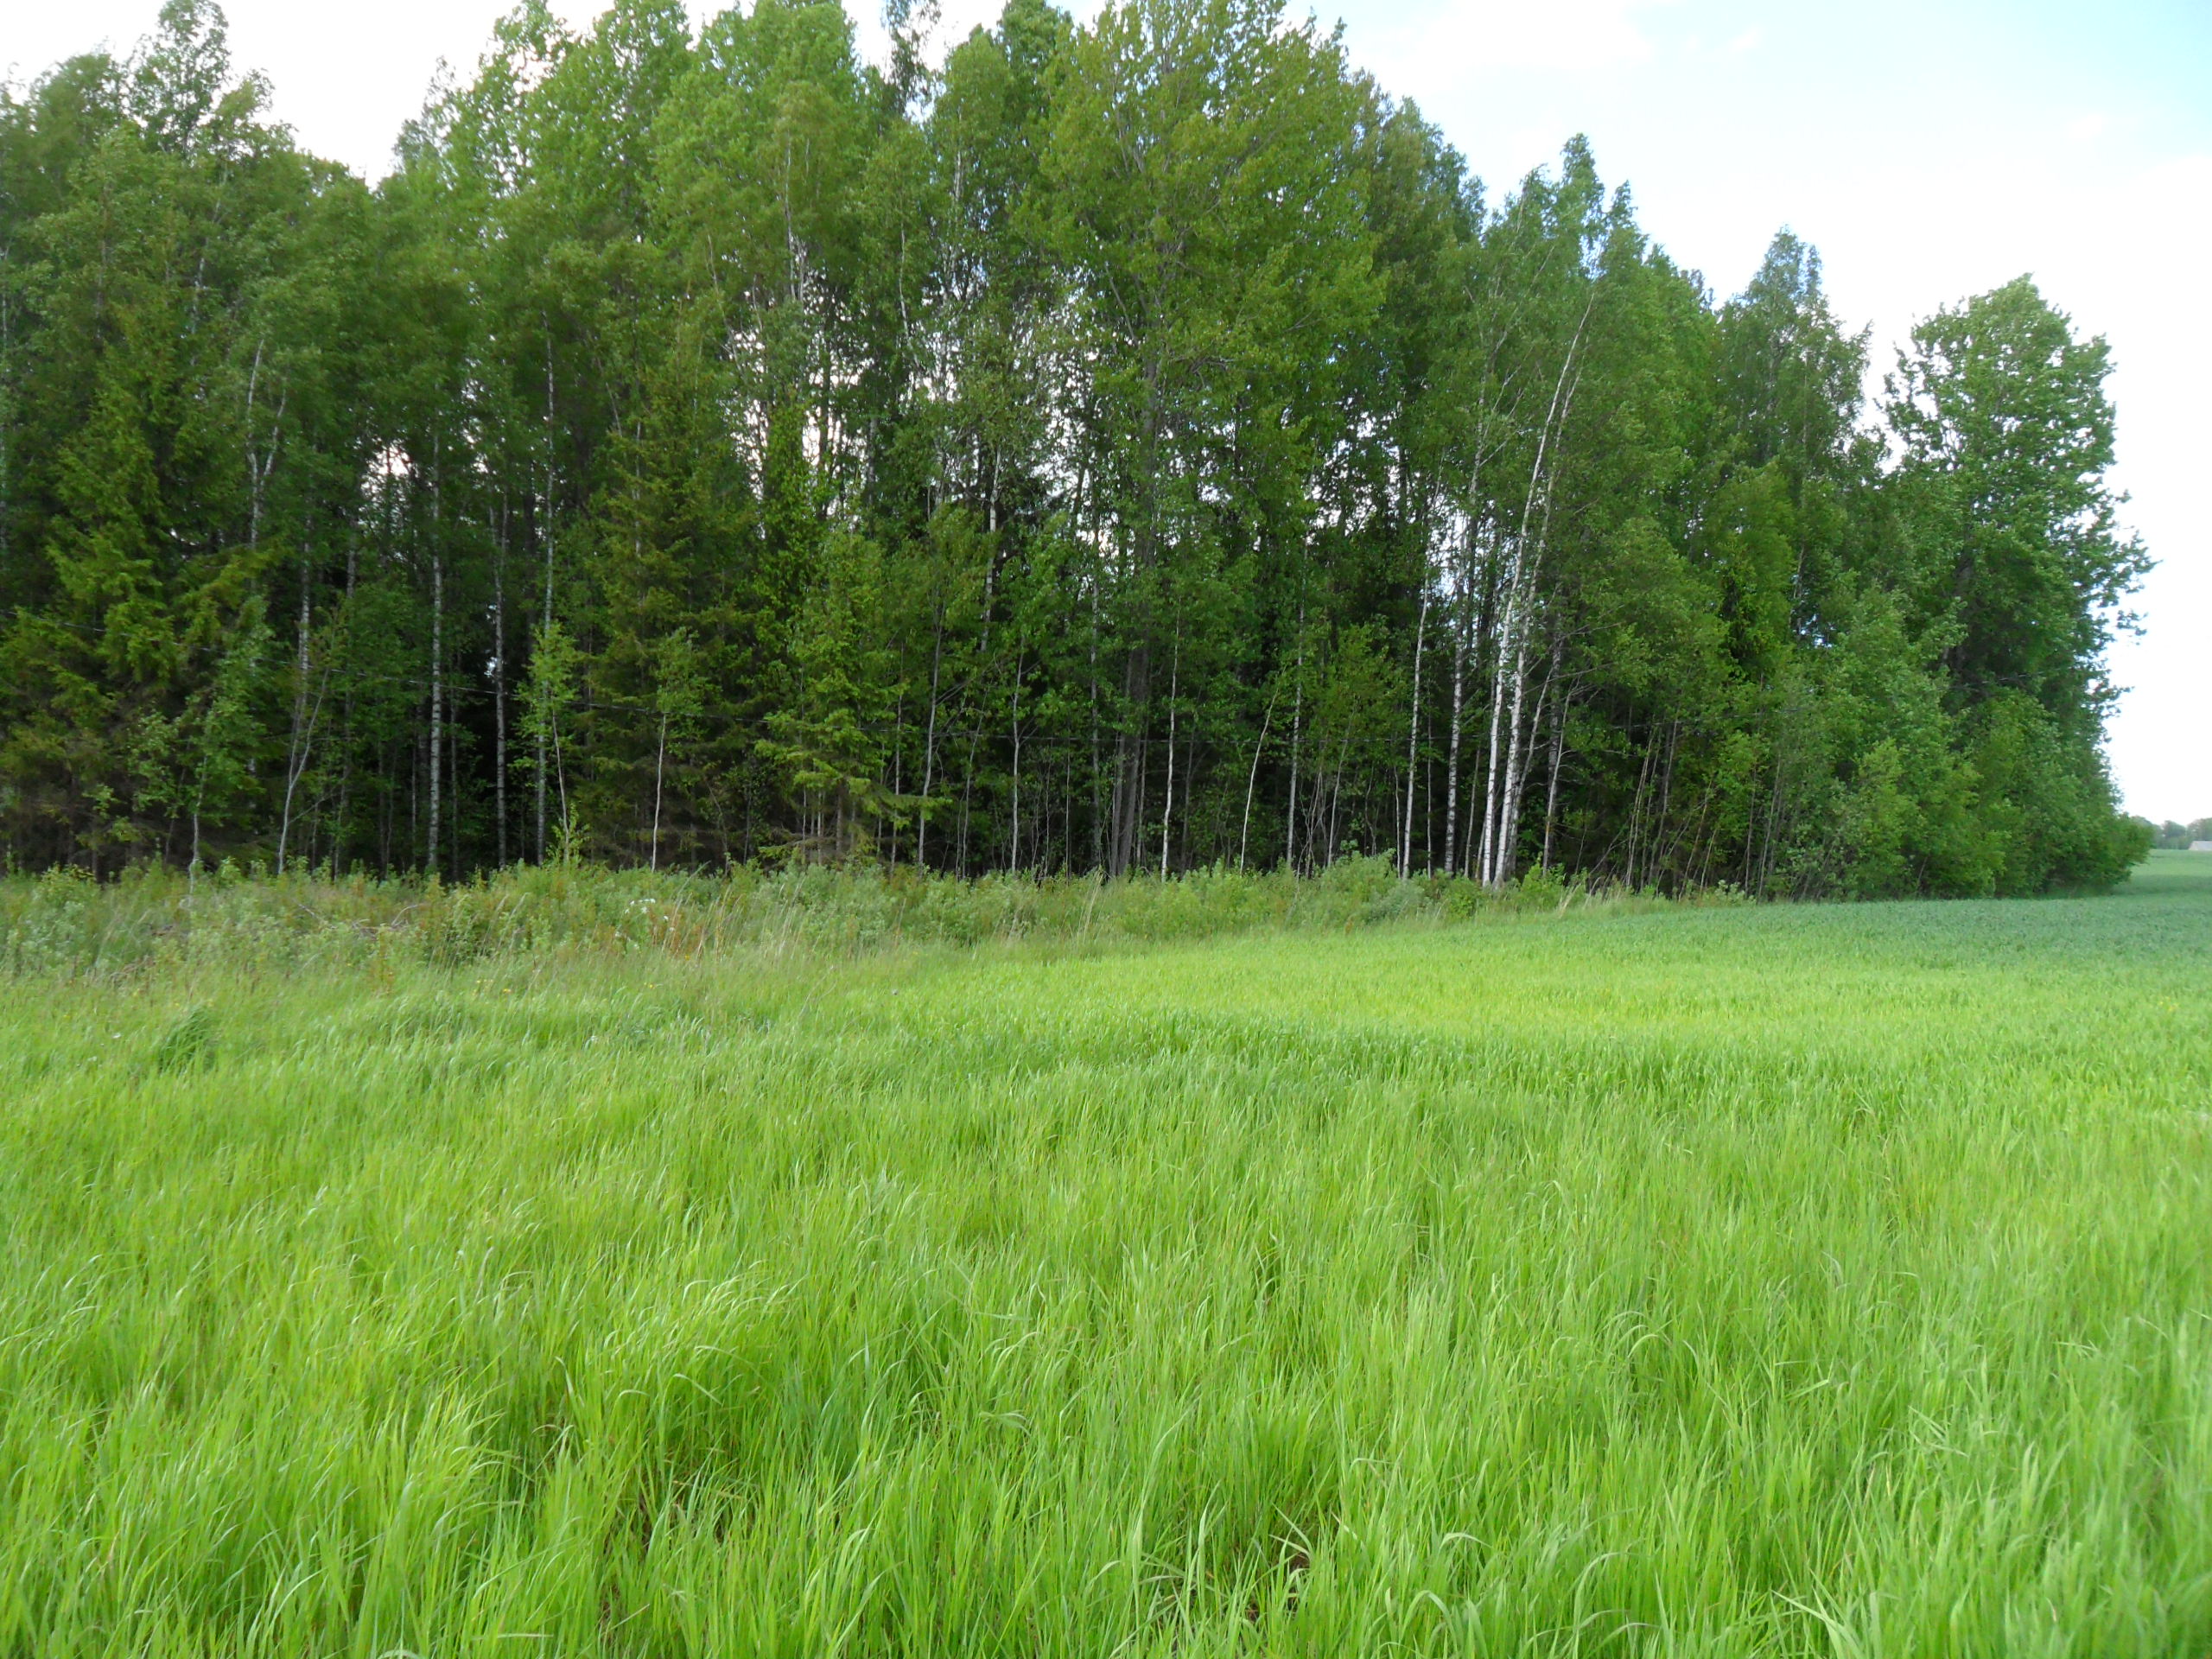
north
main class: Cropland
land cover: Temporary grasslands
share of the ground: > 75 %
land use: Agriculture (excluding fallow land and kitchen gardens)
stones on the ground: < 10 %
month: June
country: LV
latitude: 57.3300
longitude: 22.4269
